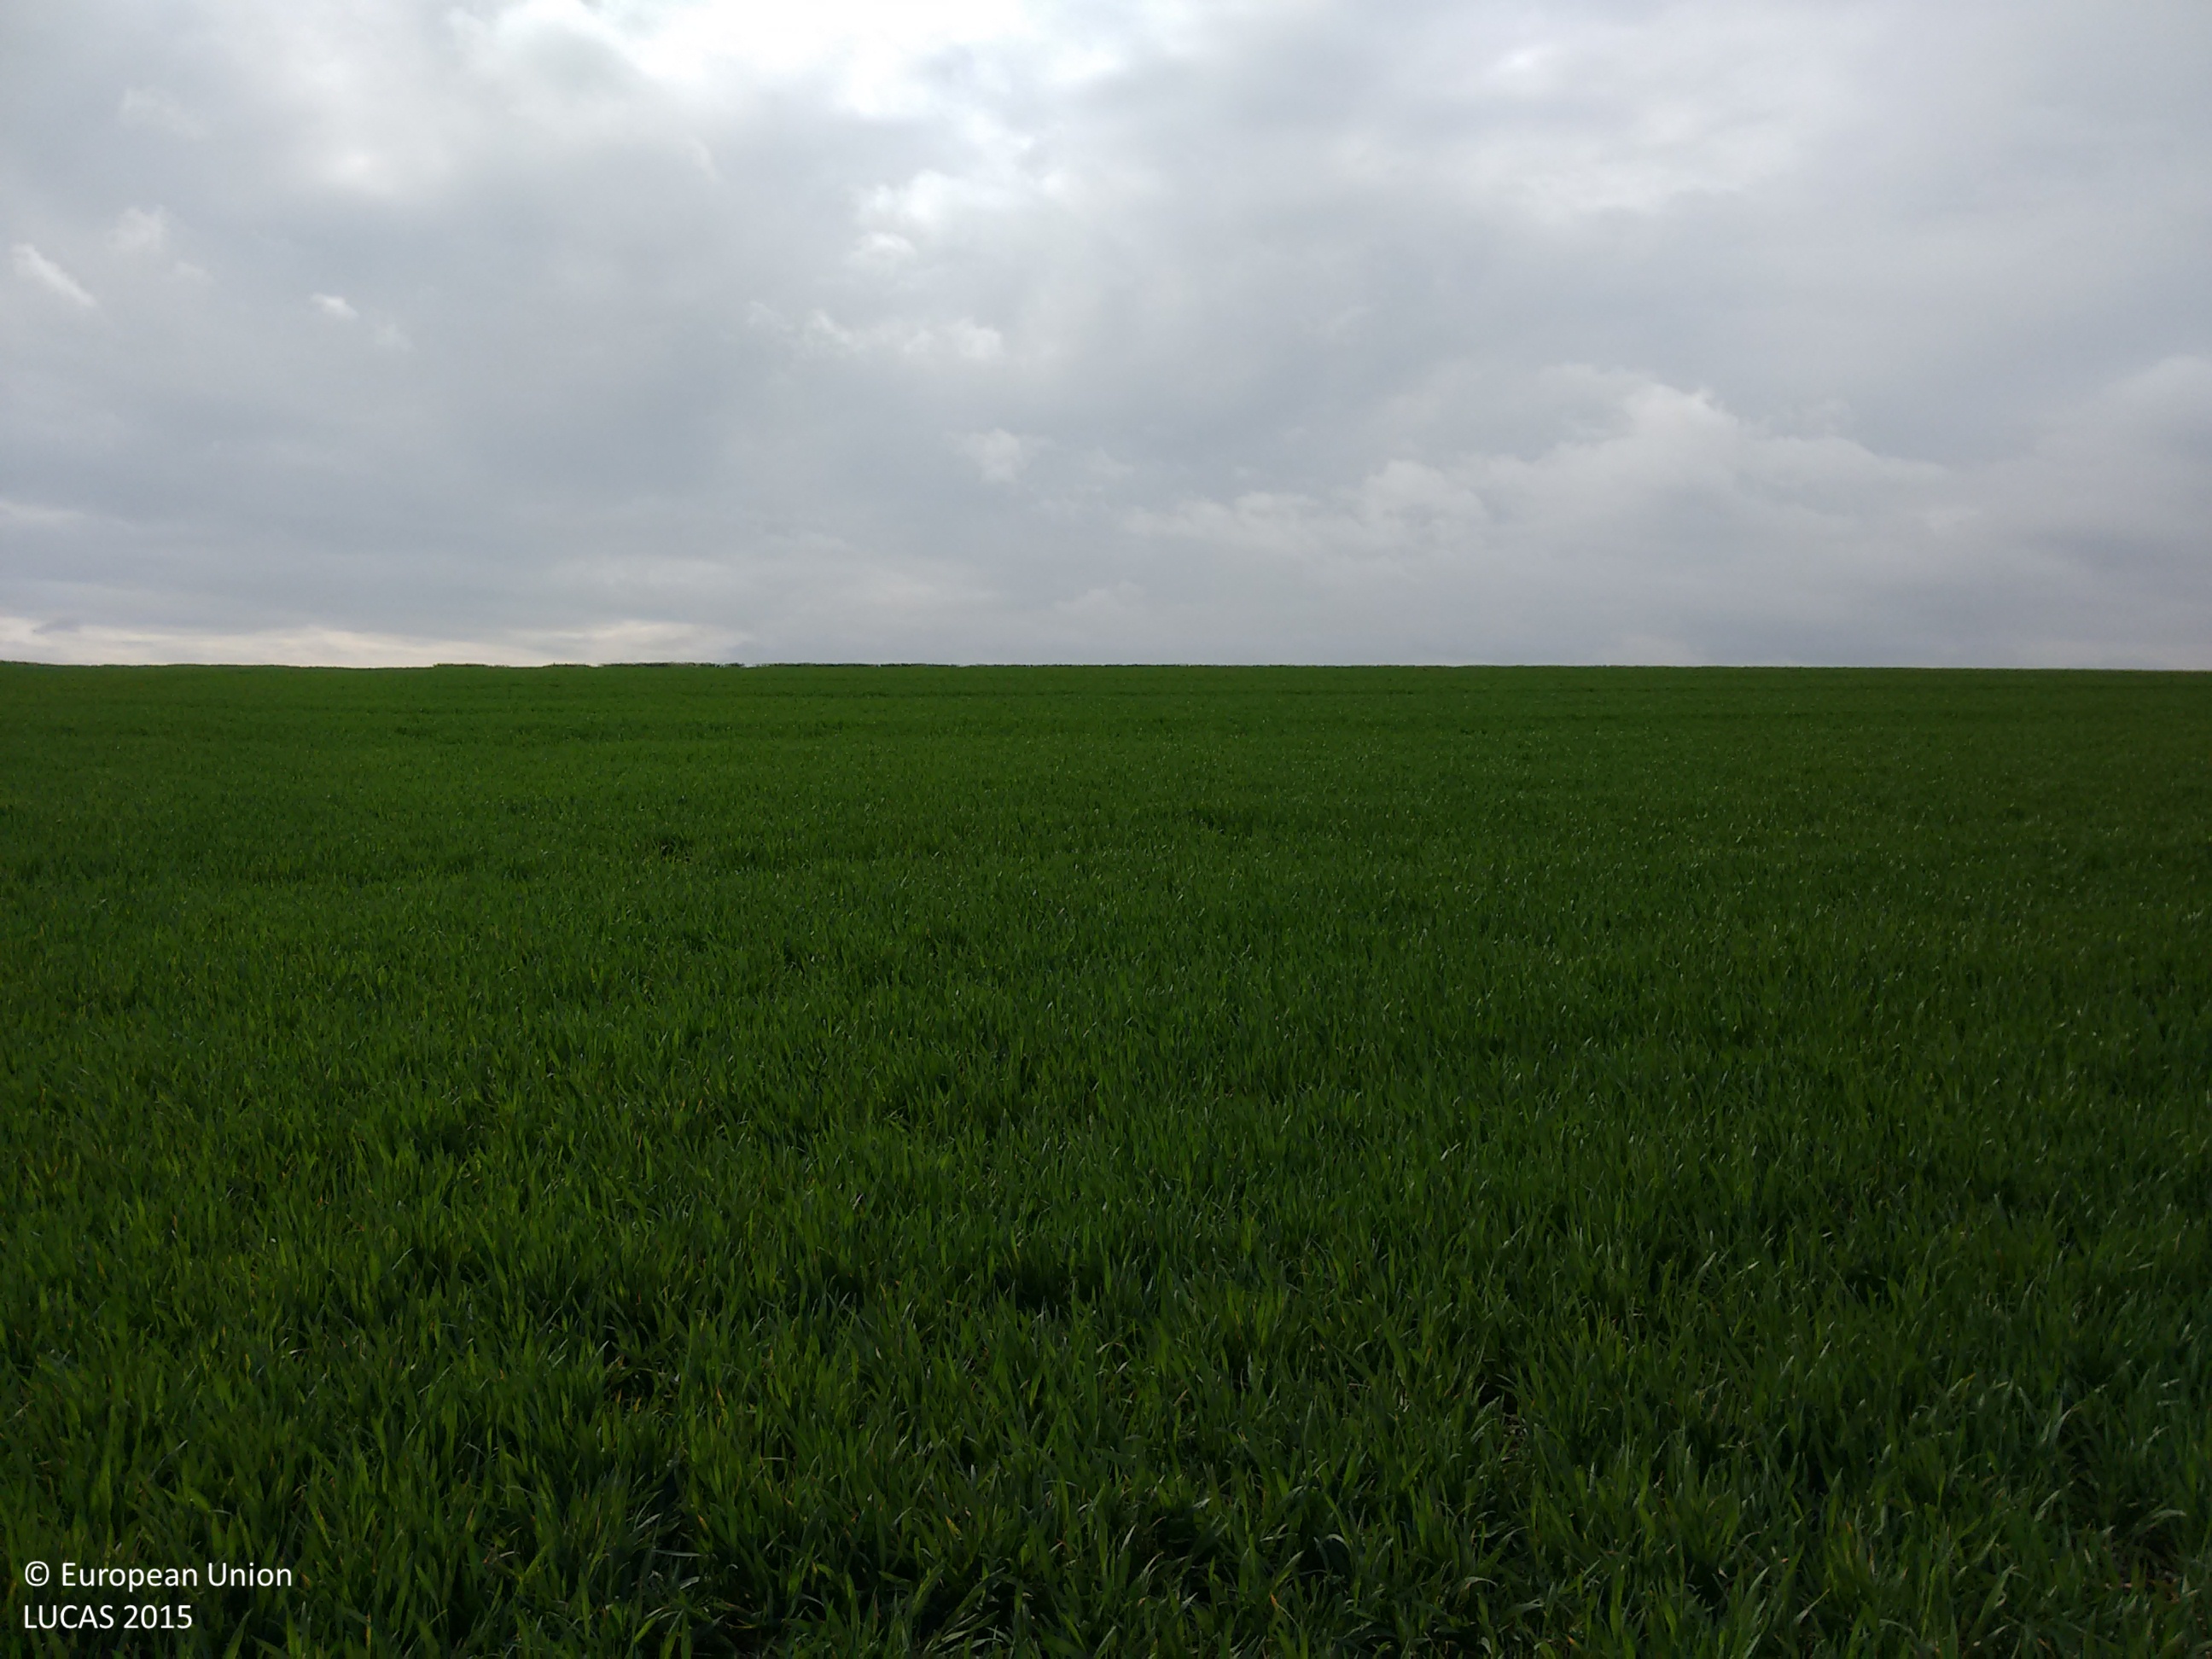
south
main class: Cropland
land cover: Common wheat
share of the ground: > 75 %
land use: Agriculture (excluding fallow land and kitchen gardens)
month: May
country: GB
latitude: 54.1219
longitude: -0.3006
